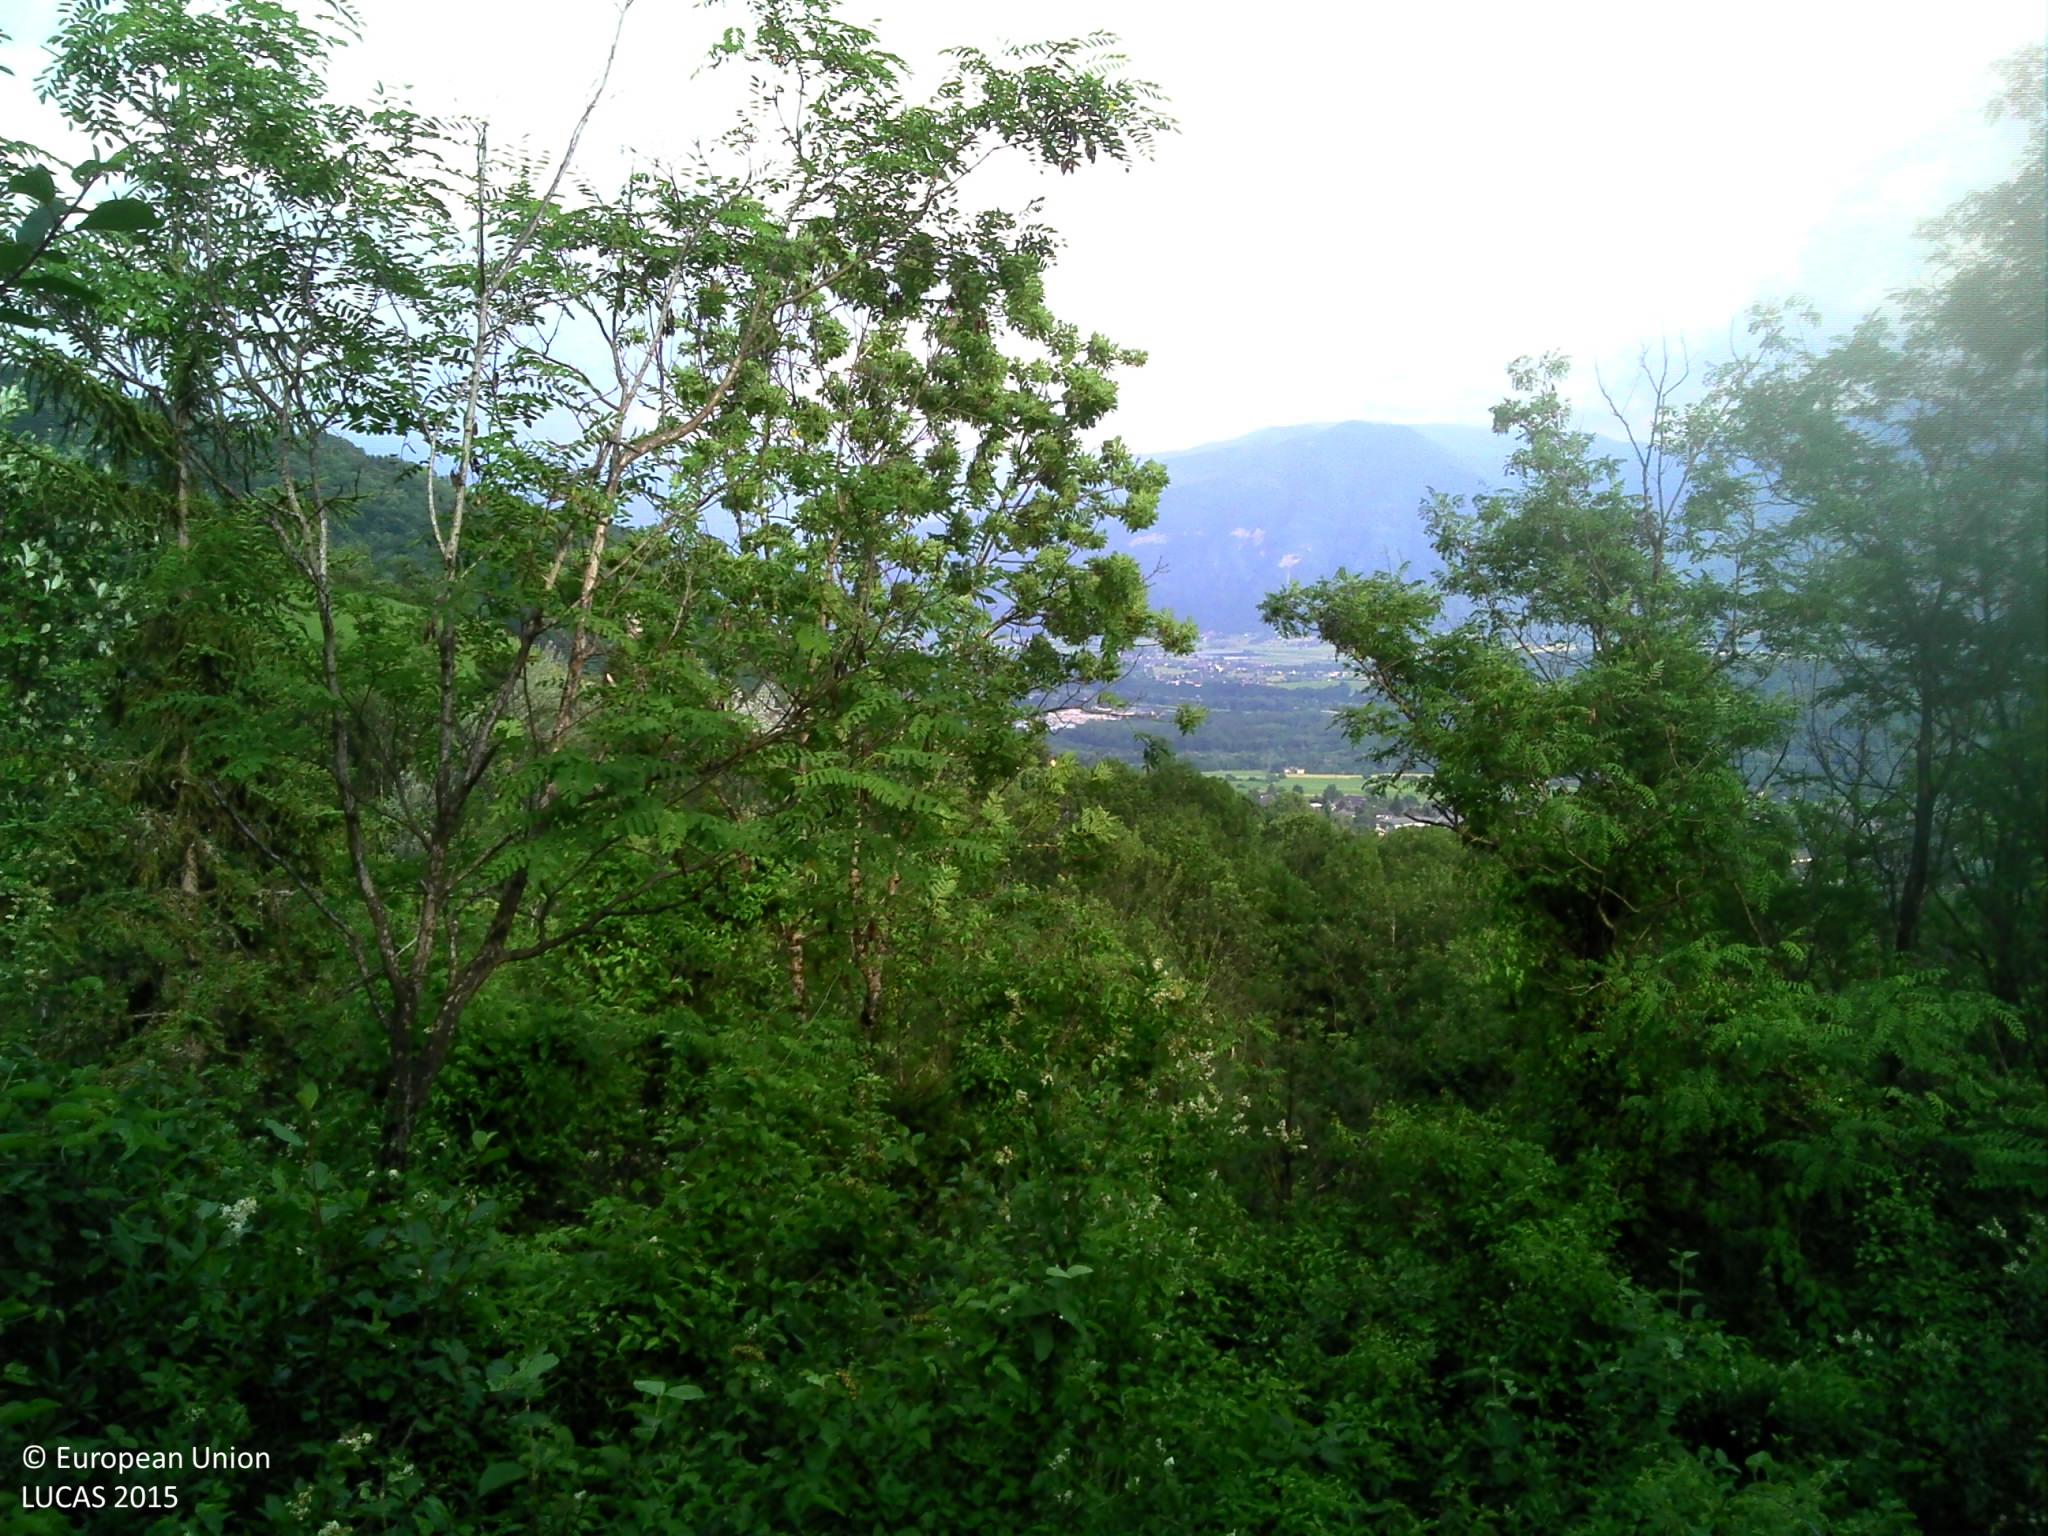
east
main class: Shrubland
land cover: Shrubland with sparse tree cover
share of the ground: > 75 %
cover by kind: shrubs 80 %, herbaceous plants 15 %, broadleaved forest trees 5 %
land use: Forestry
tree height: > 5 m
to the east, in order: Shrubland with sparse tree cover; Broadleaved woodland; Spontaneously vegetated surfaces; Broadleaved woodland; Grass margins; Paved roads, cycling and walking lanes; Grass margins; Fences; Grassland without tree/shrub cover; Fences; Dry stone walls; Electric lines; Abandoned hedges
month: June
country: FR
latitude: 45.5784
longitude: 6.1471
